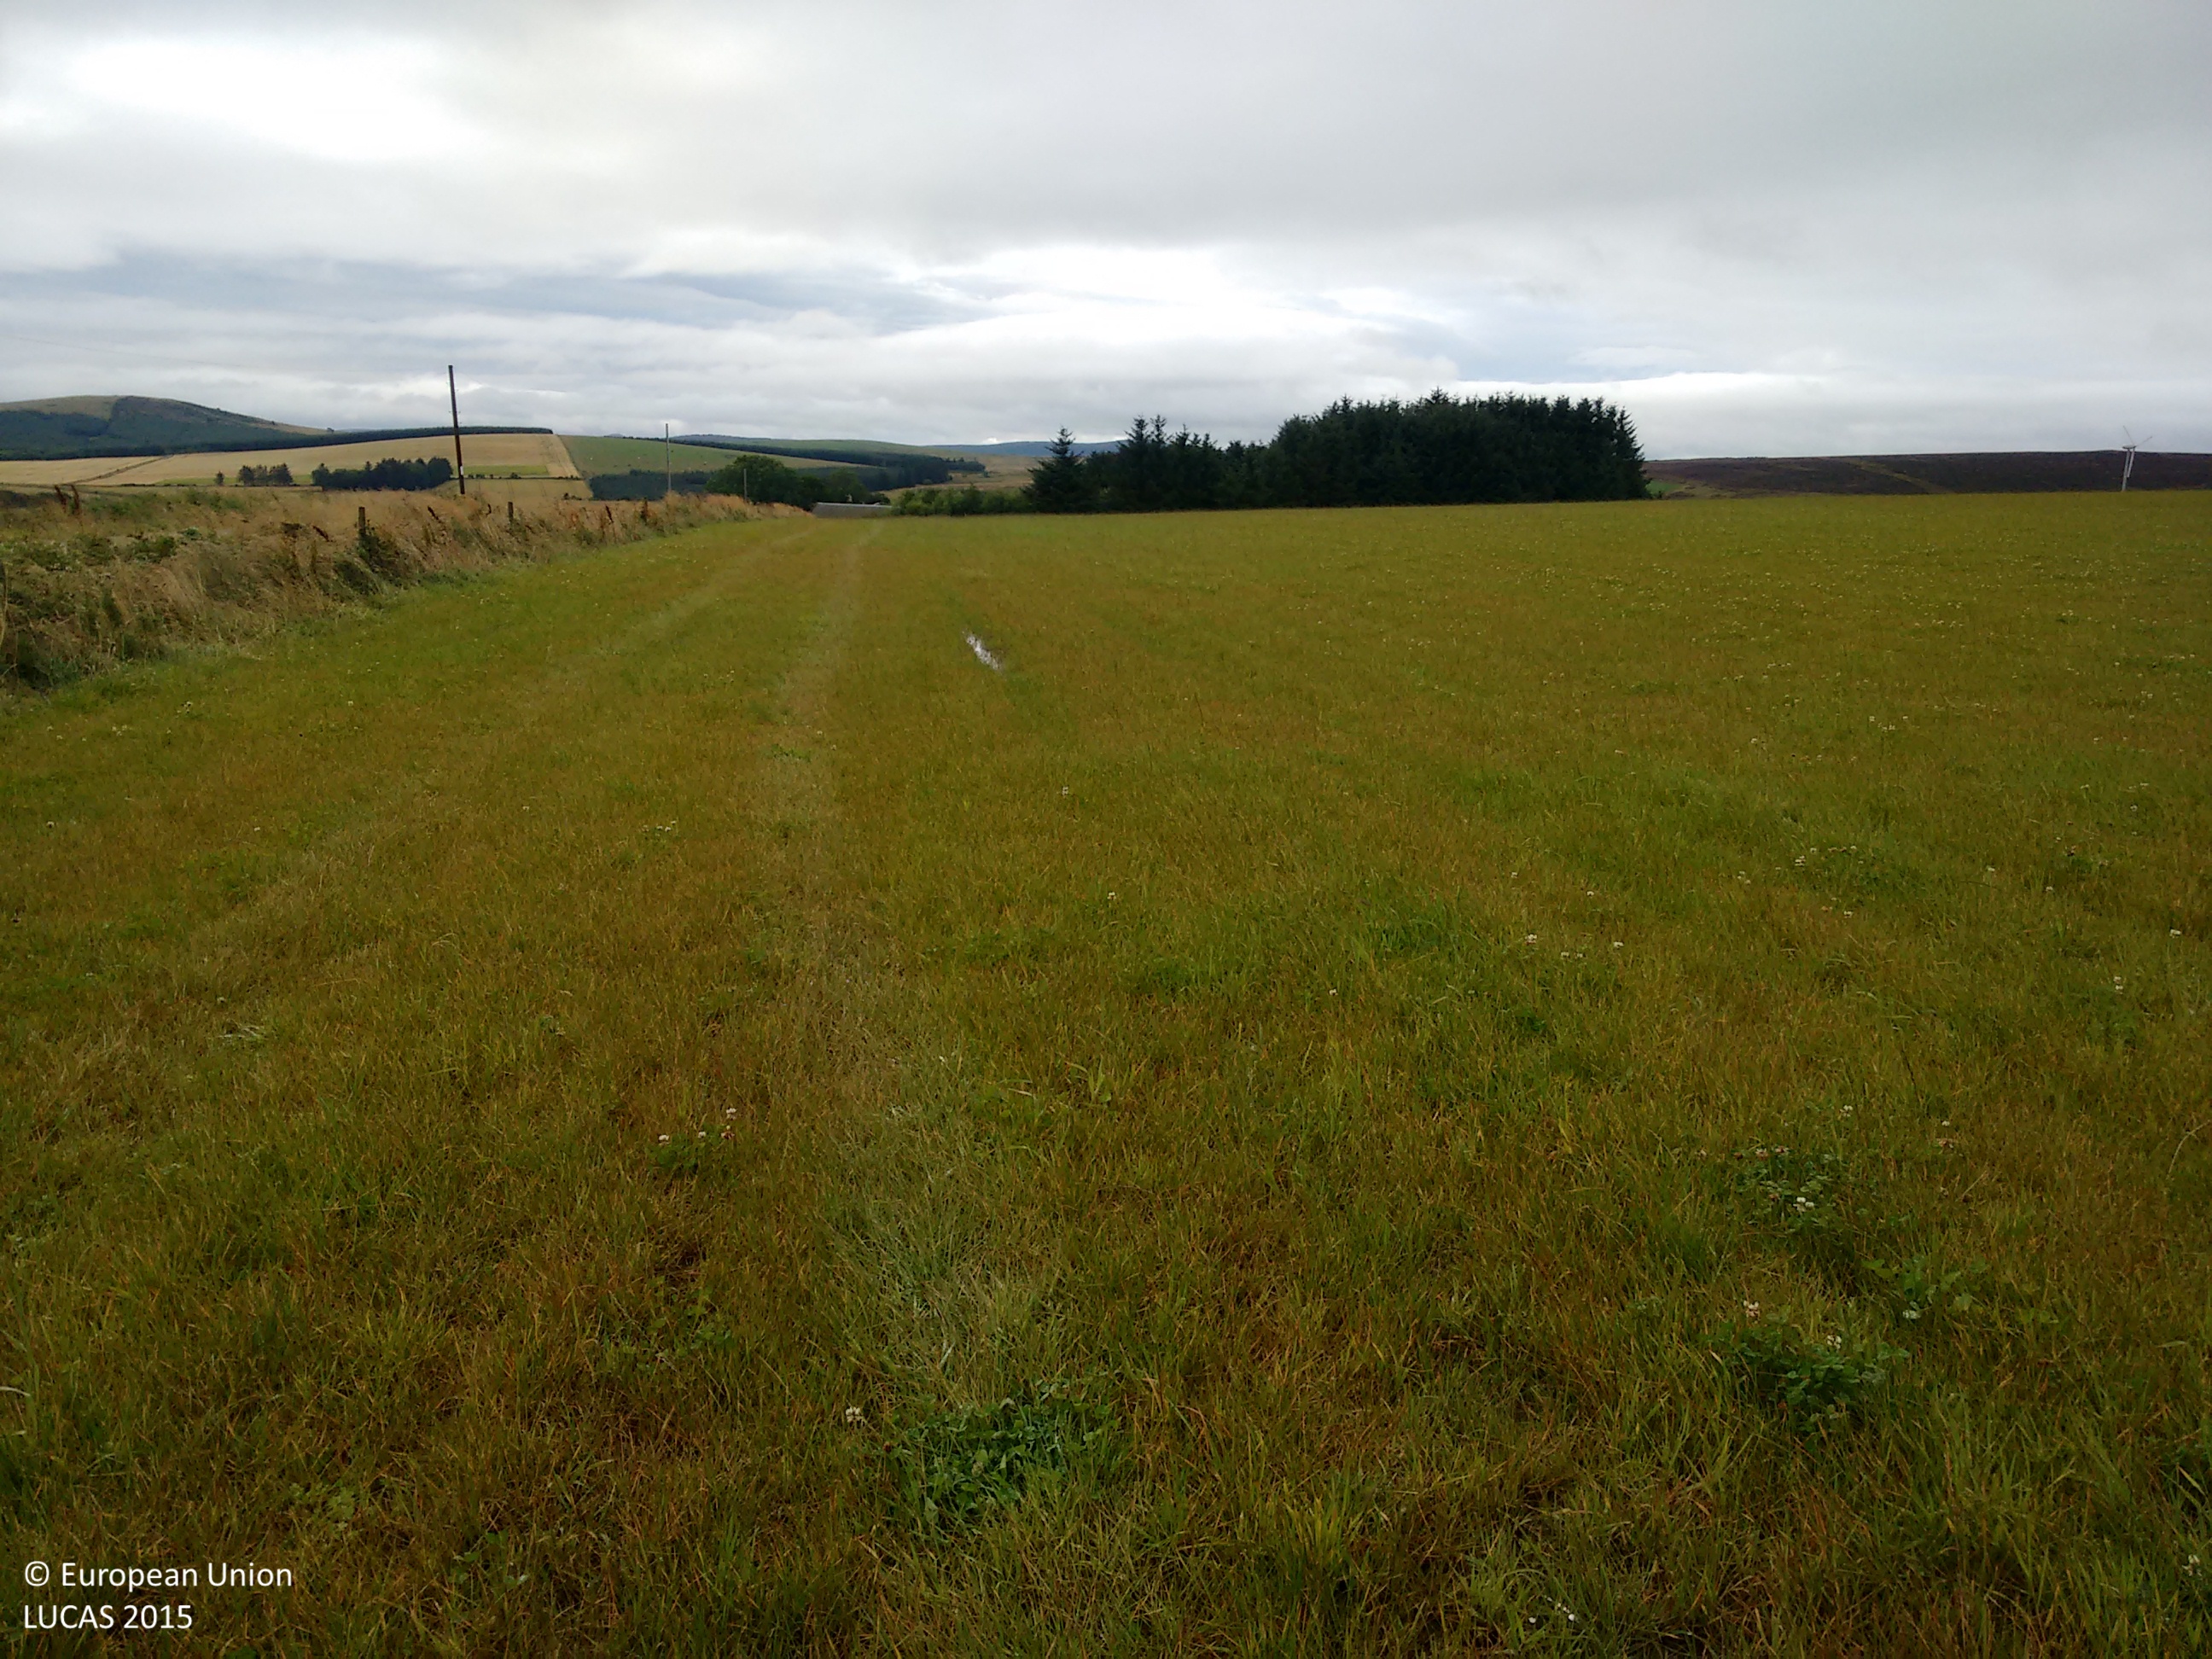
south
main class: Grassland
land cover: Grassland without tree/shrub cover
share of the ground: > 75 %
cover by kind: herbaceous plants 95 %, unconsolidated bare surface 5 %
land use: Agriculture (excluding fallow land and kitchen gardens)
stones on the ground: 10 - 25 %
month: September
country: GB
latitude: 57.5006
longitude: -2.9259
